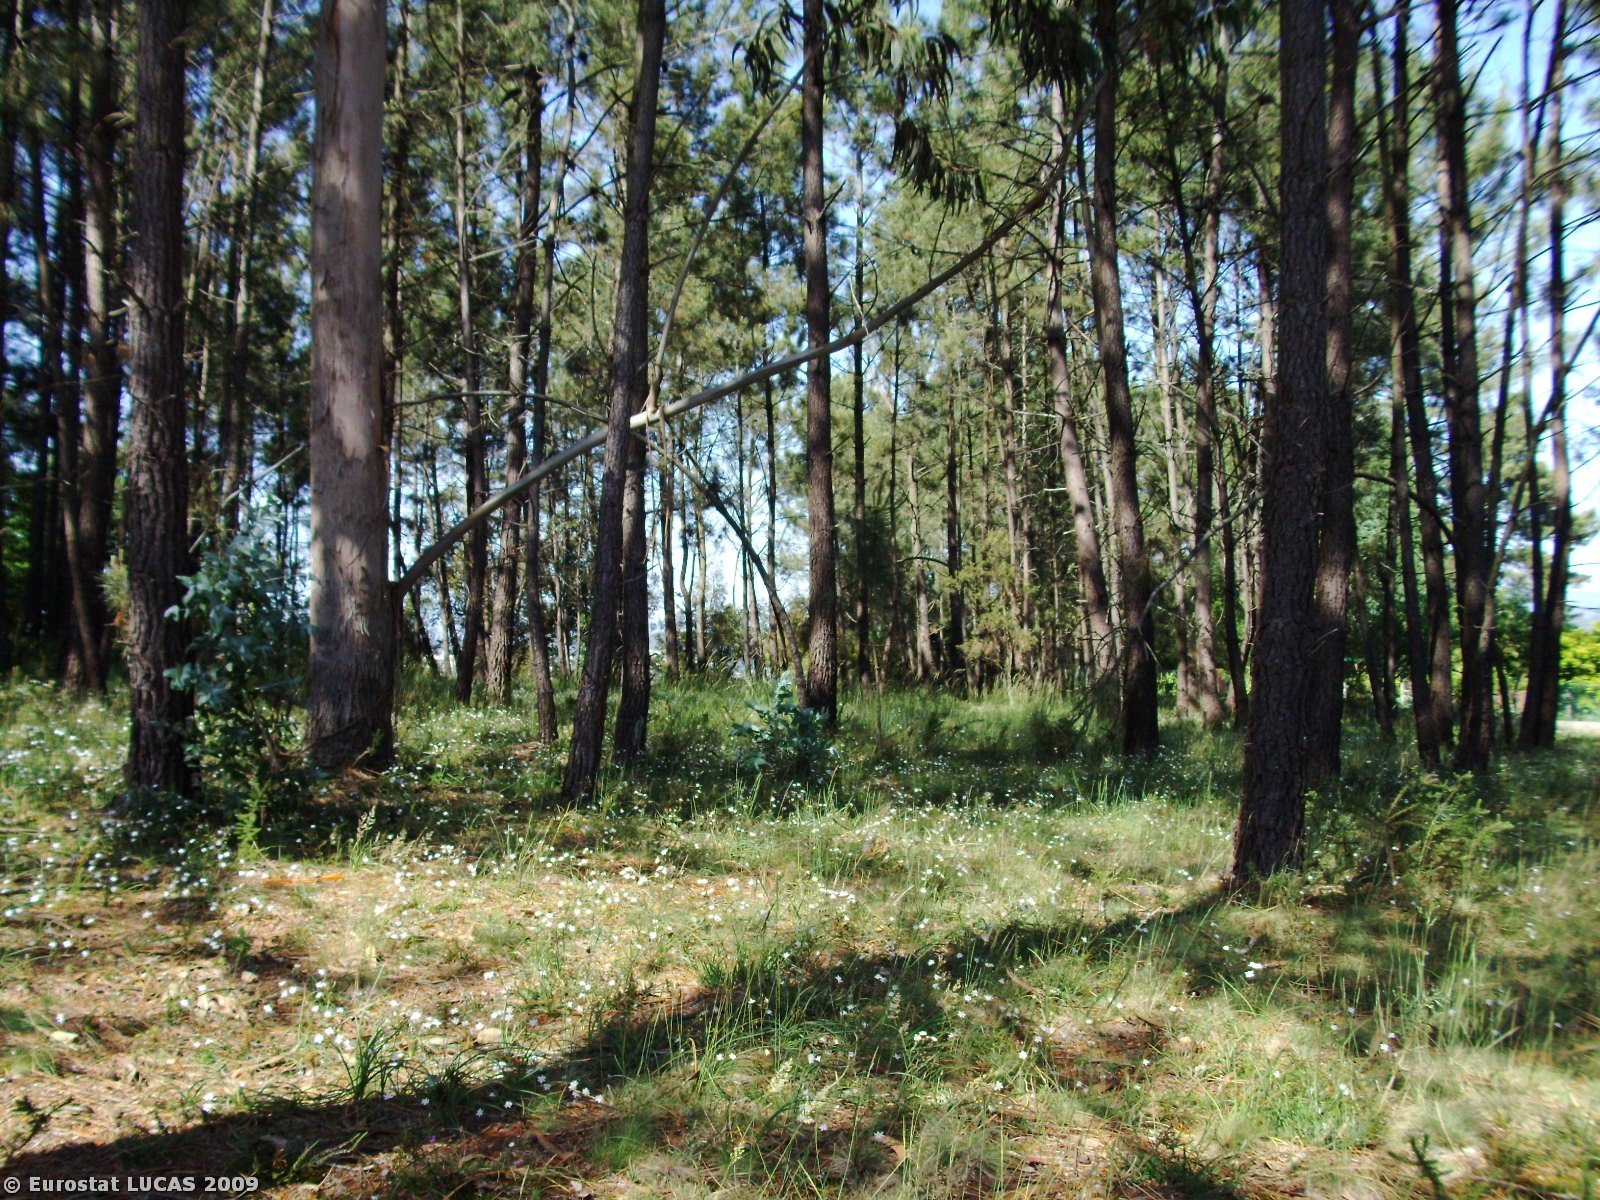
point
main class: Woodland
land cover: Coniferous woodland
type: coniferous forest of the mediterranean region
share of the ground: > 75 %
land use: Forestry
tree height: > 5 m
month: May
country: PT
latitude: 40.6096
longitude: -8.4460
